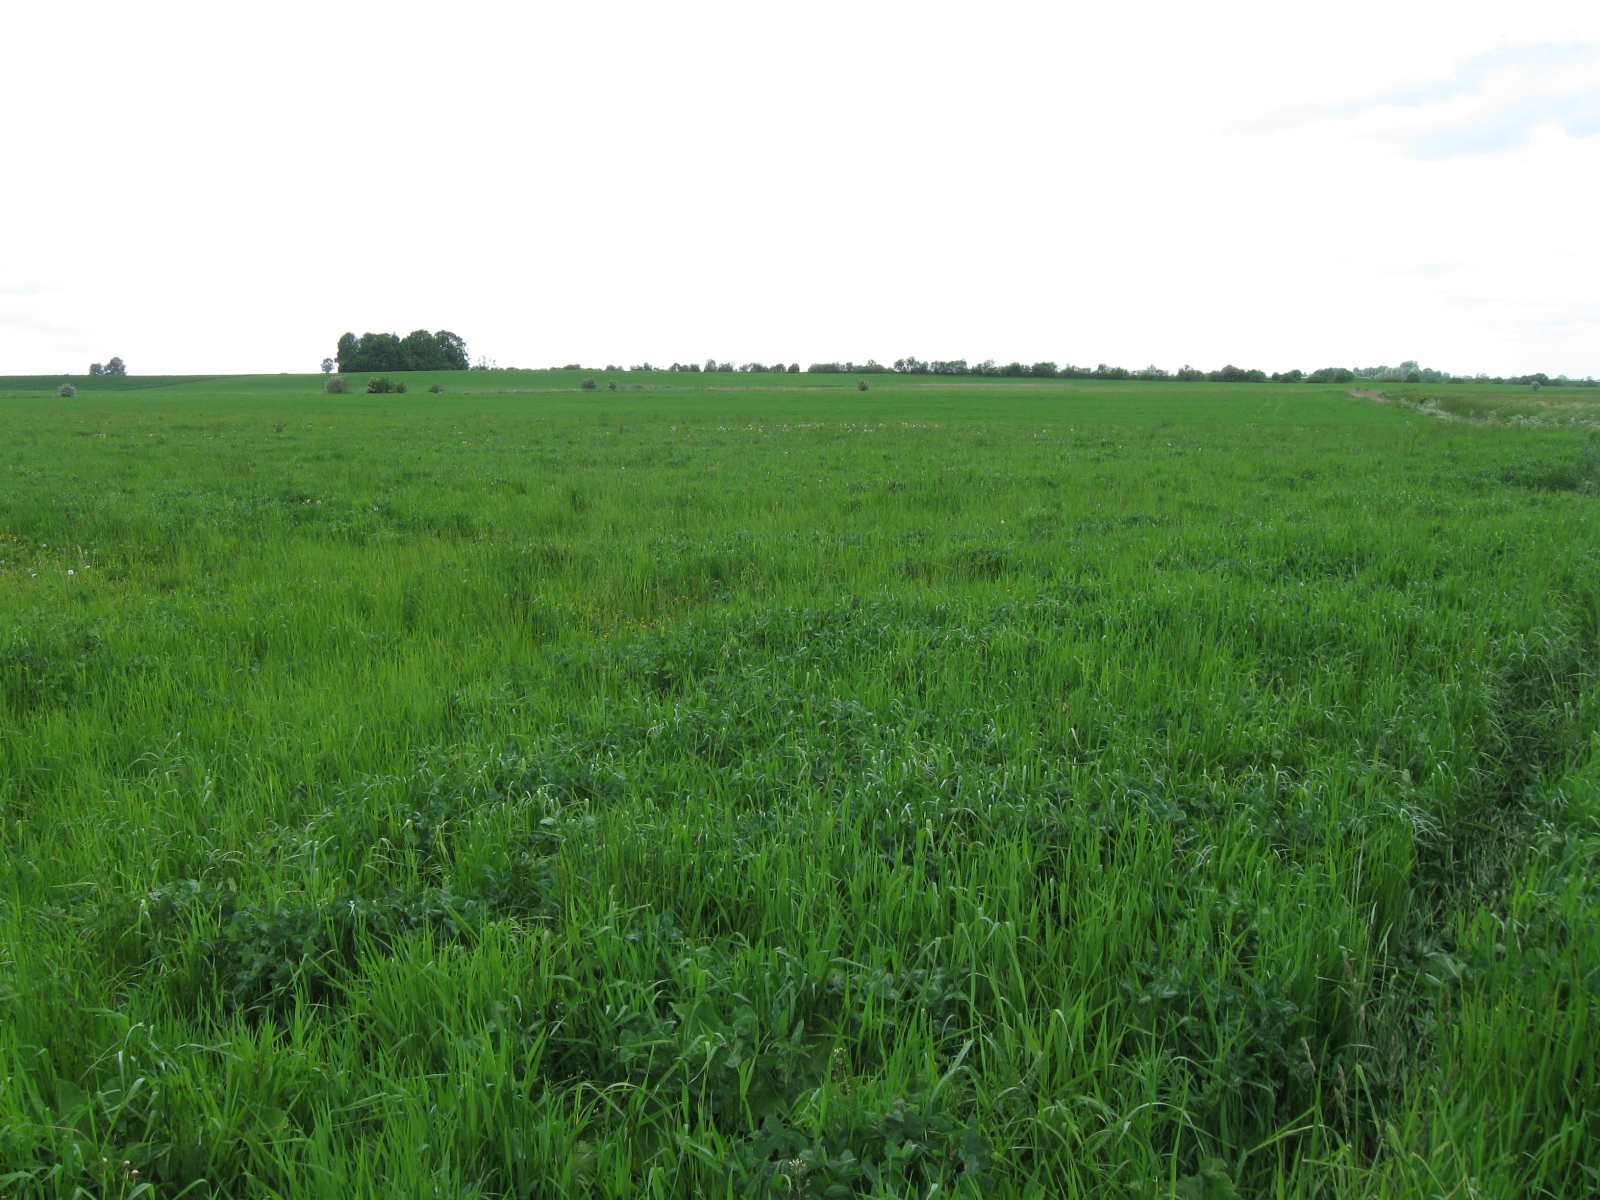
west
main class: Grassland
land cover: Grassland without tree/shrub cover
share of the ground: > 75 %
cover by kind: herbaceous plants 100 %
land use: Agriculture (excluding fallow land and kitchen gardens)
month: May
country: LT
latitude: 54.6894
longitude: 22.7734
